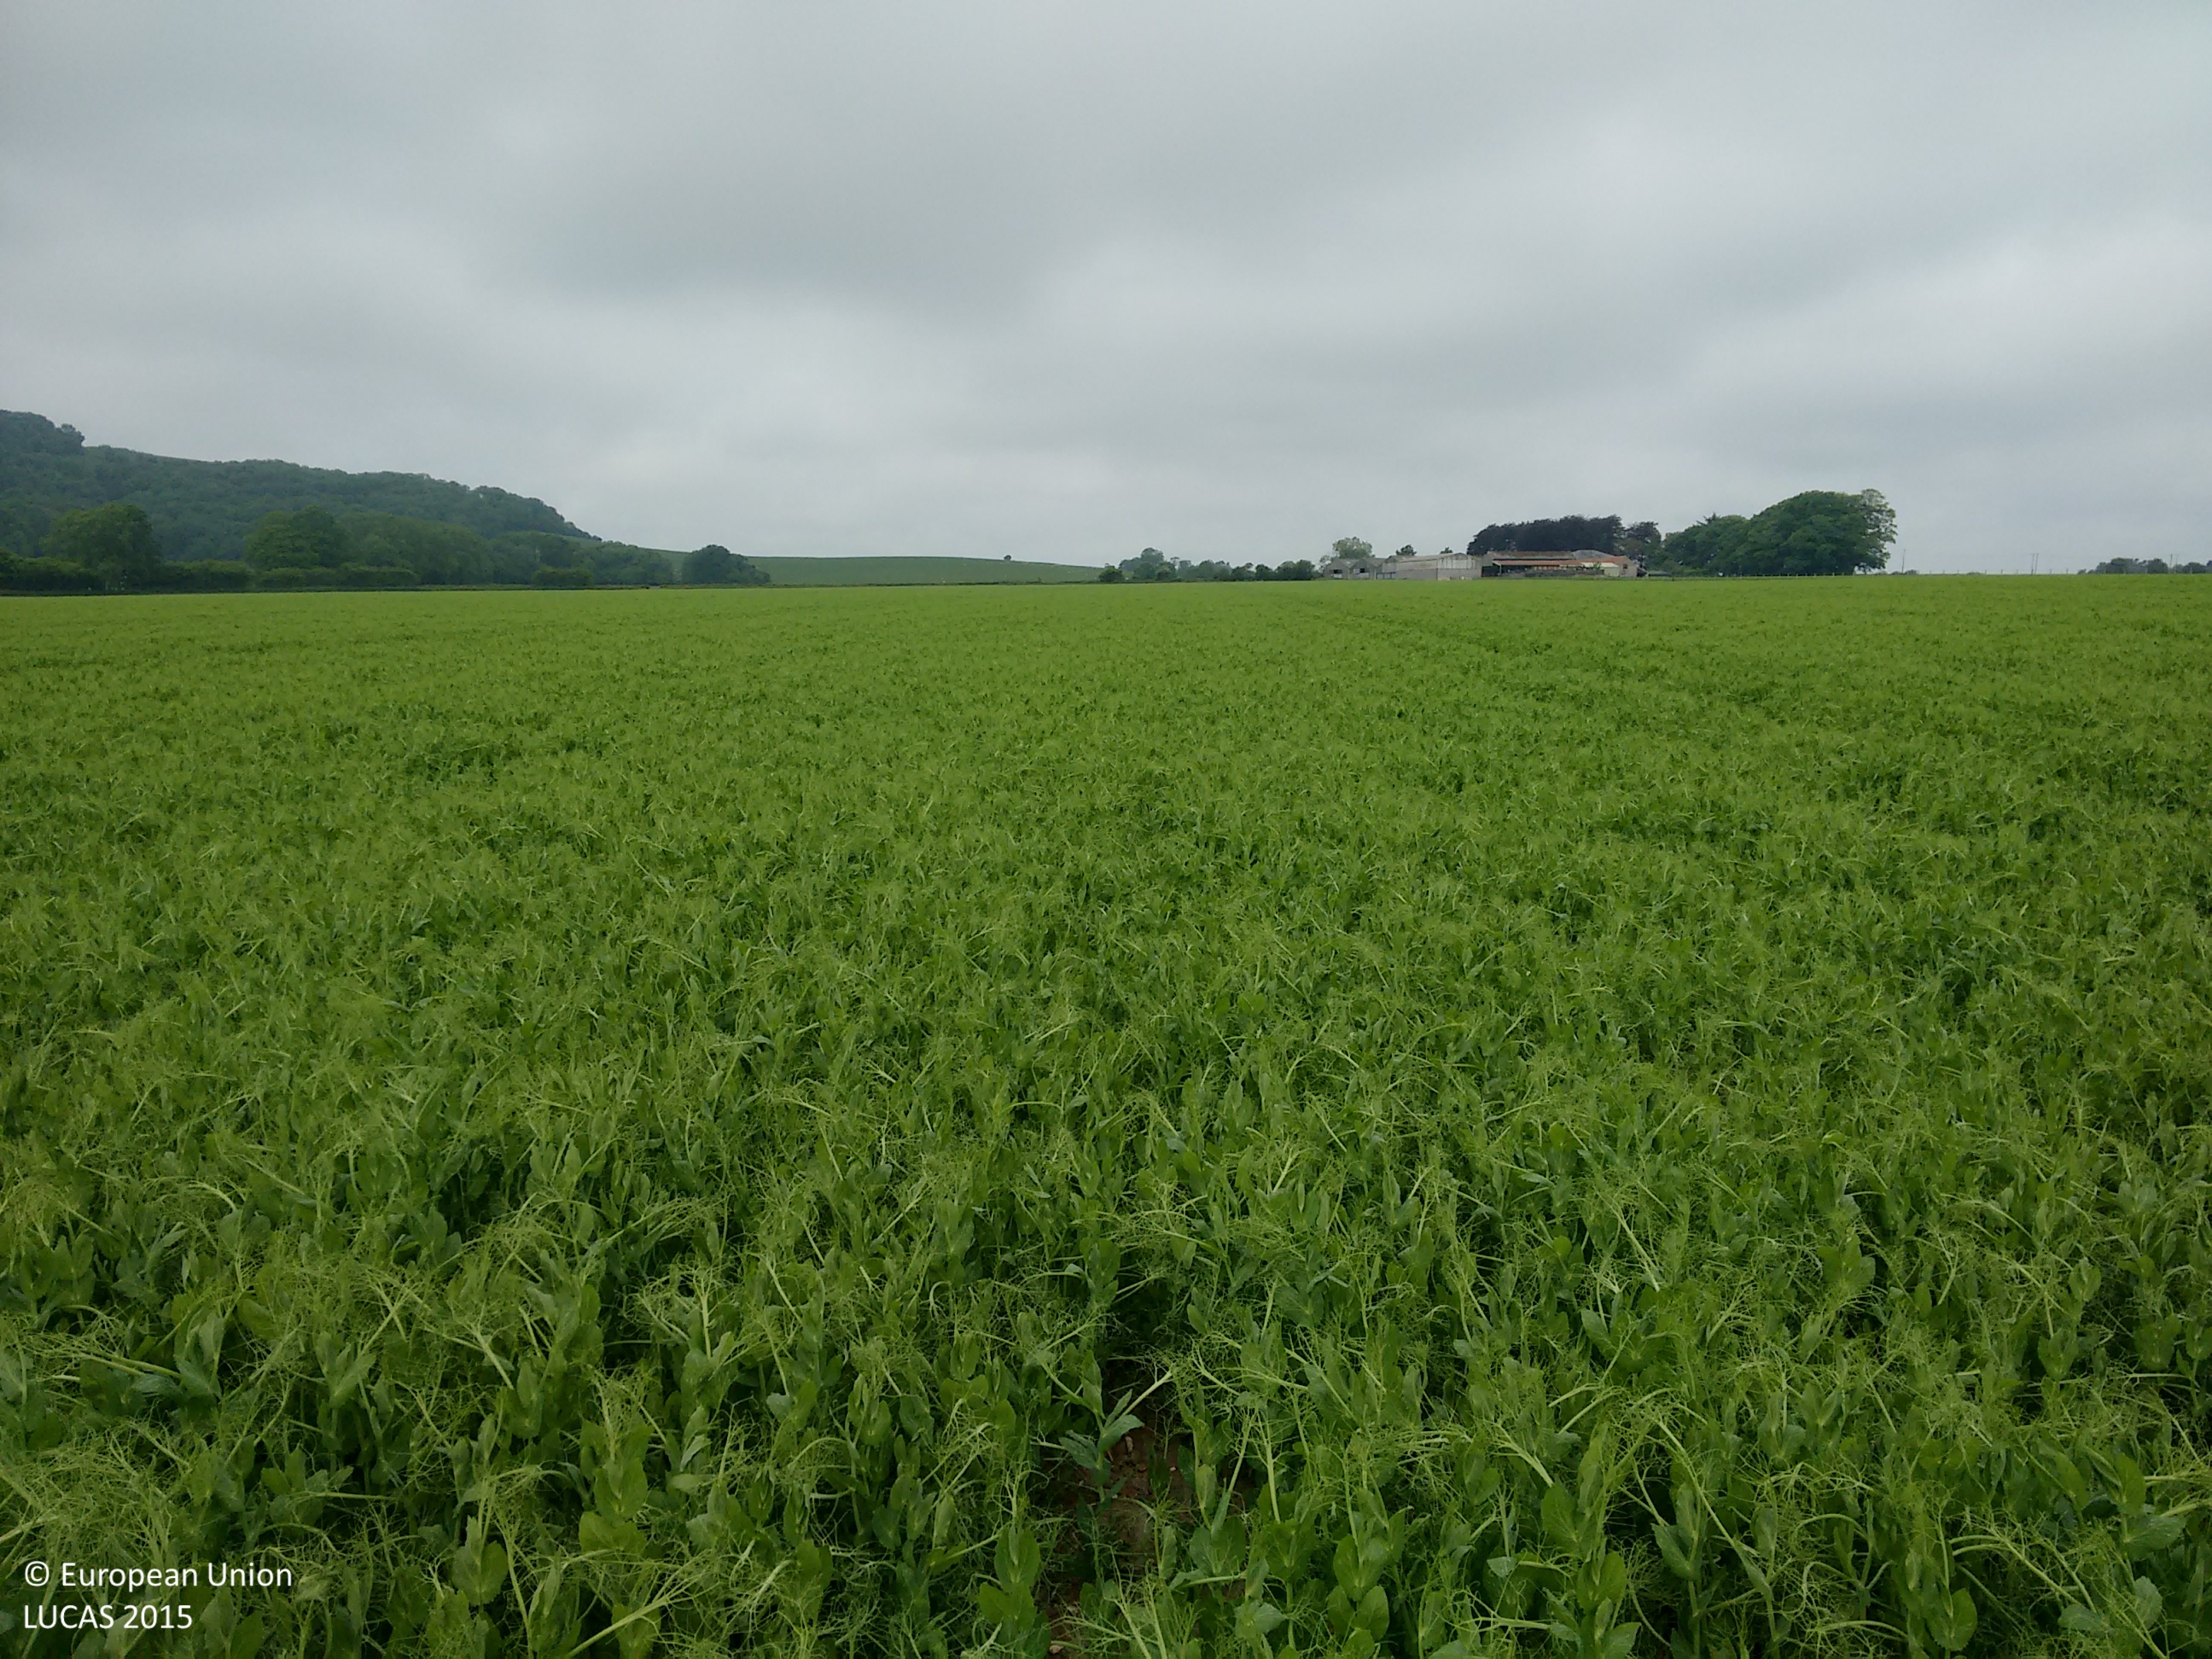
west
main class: Cropland
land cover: Dry pulses
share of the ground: > 75 %
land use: Agriculture (excluding fallow land and kitchen gardens)
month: June
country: GB
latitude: 51.1600
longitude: -2.2305
